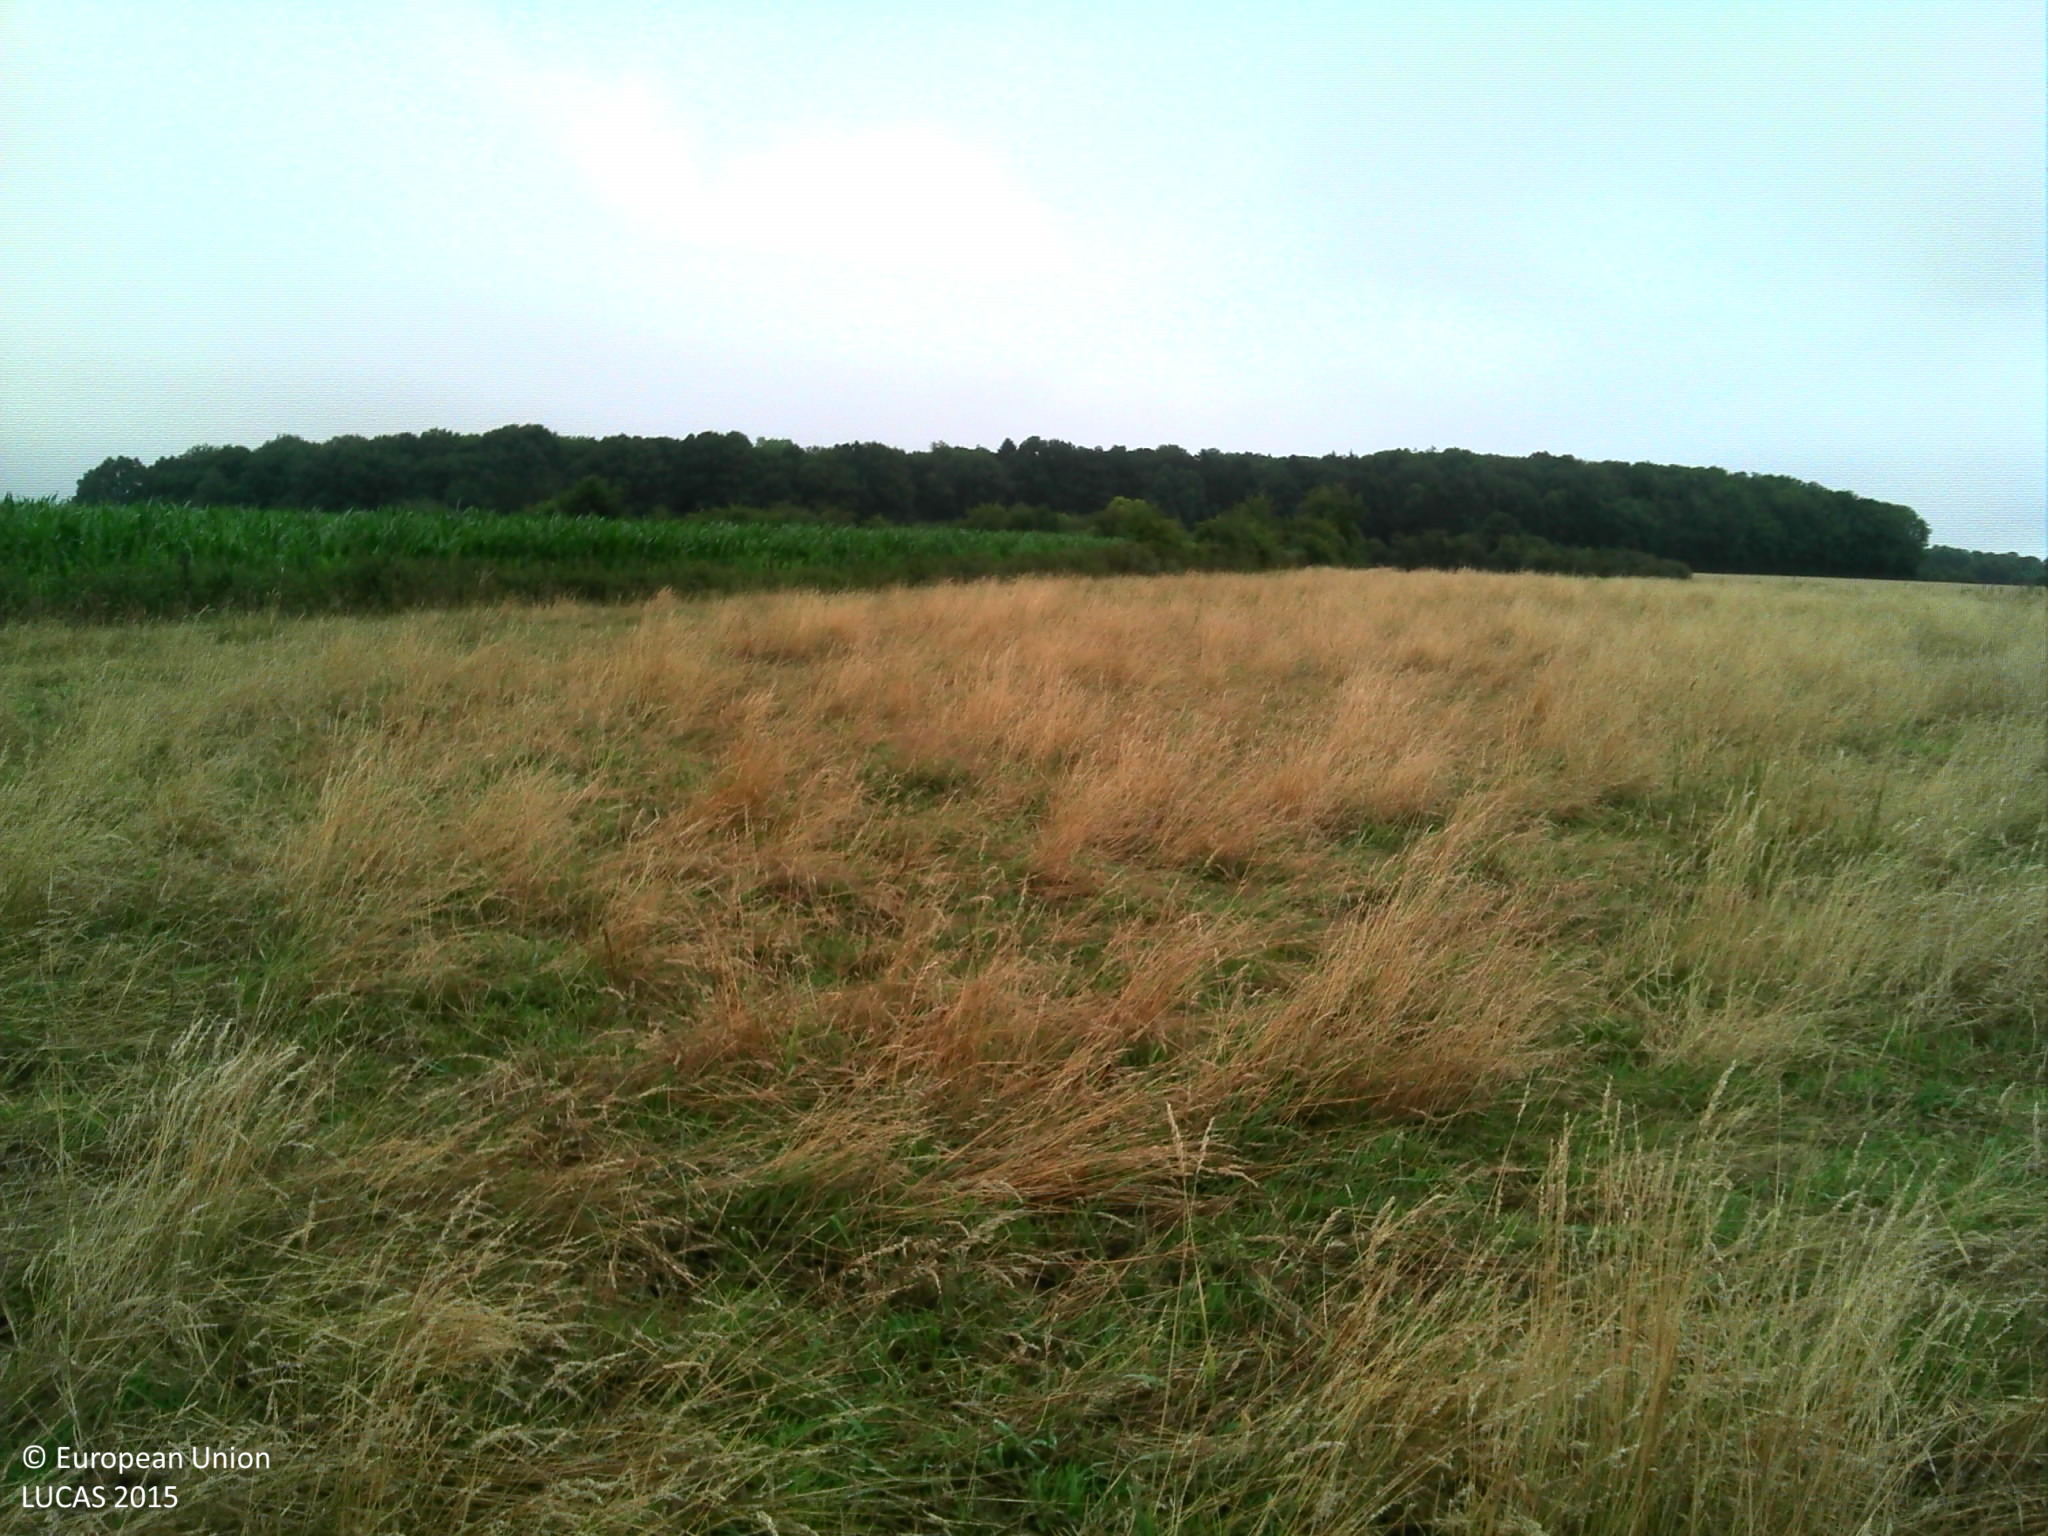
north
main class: Grassland
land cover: Grassland without tree/shrub cover
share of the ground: > 75 %
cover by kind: herbaceous plants 100 %
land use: Agriculture (excluding fallow land and kitchen gardens)
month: July
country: BE
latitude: 50.2006
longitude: 4.6025
